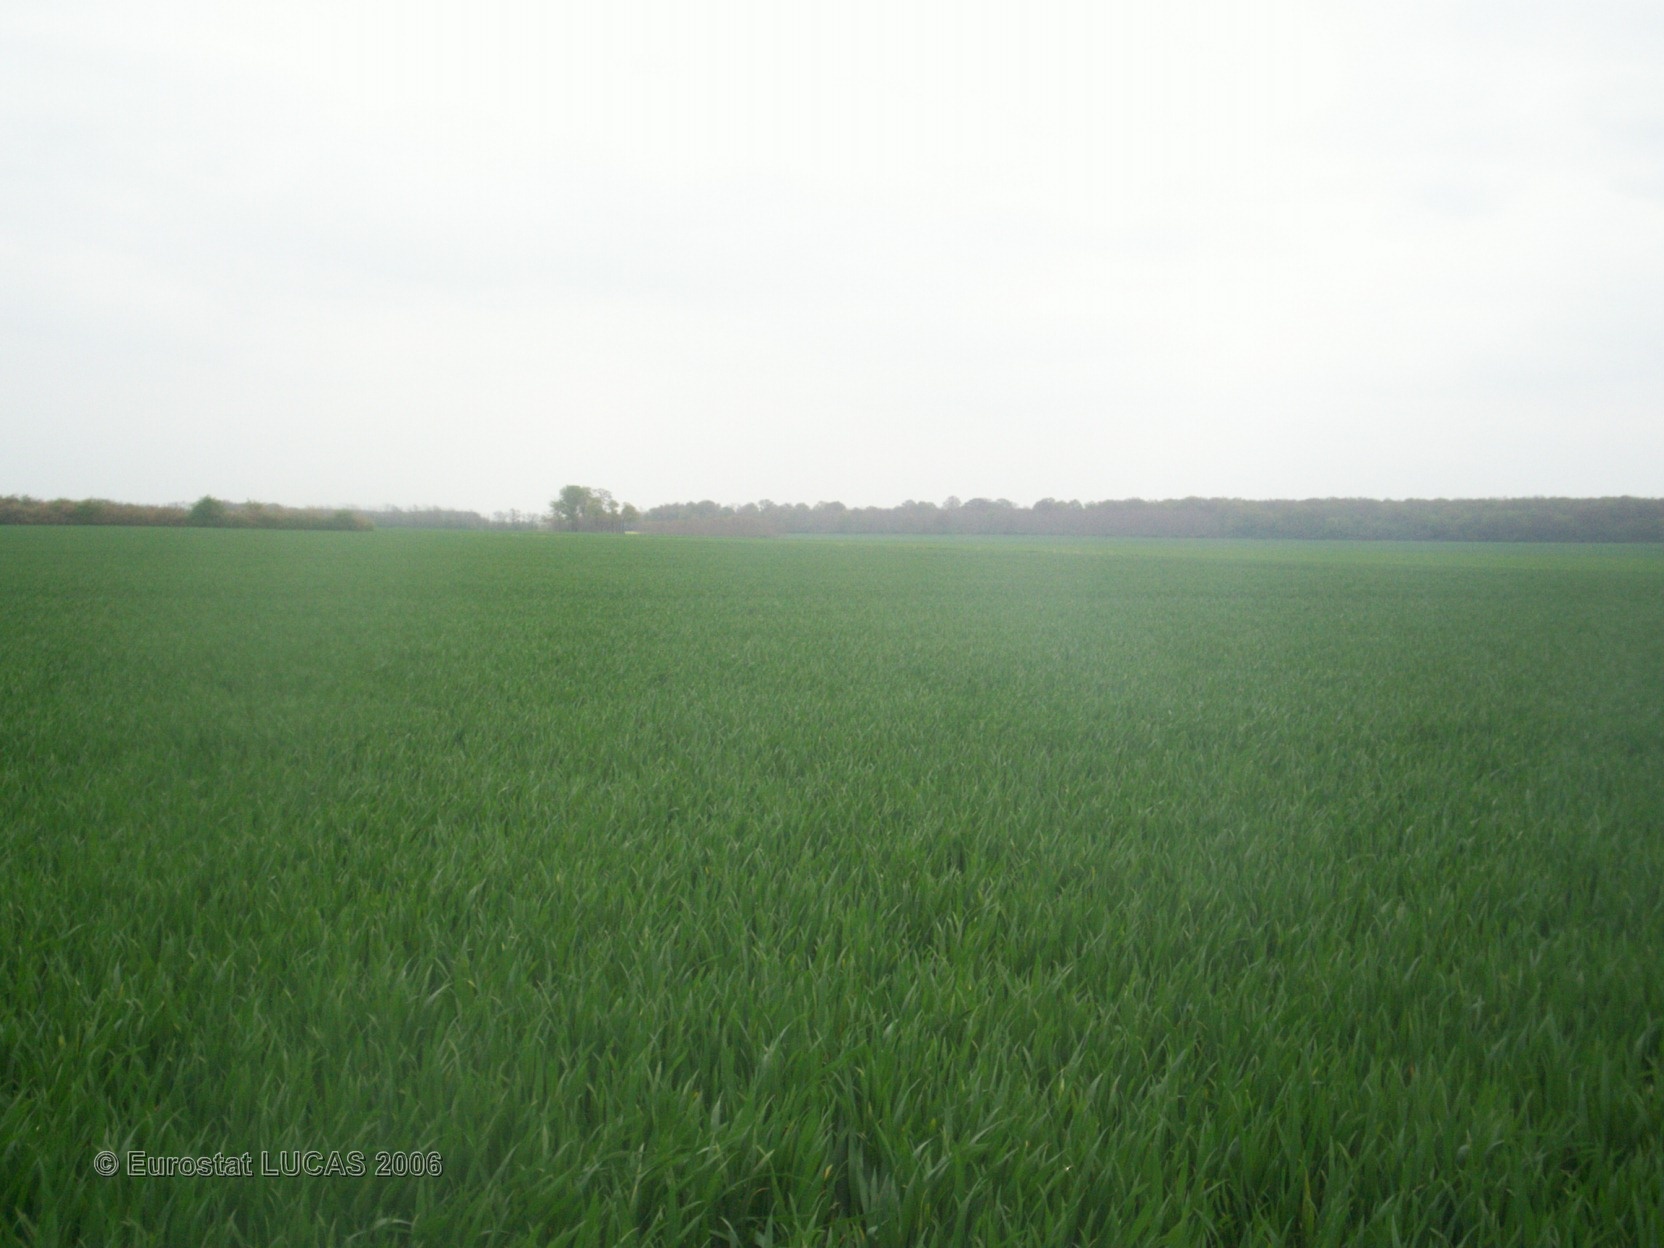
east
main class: Cropland
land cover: Common wheat
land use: Agriculture (excluding fallow land and kitchen gardens)
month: April
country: FR
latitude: 47.7082
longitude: 1.2003
